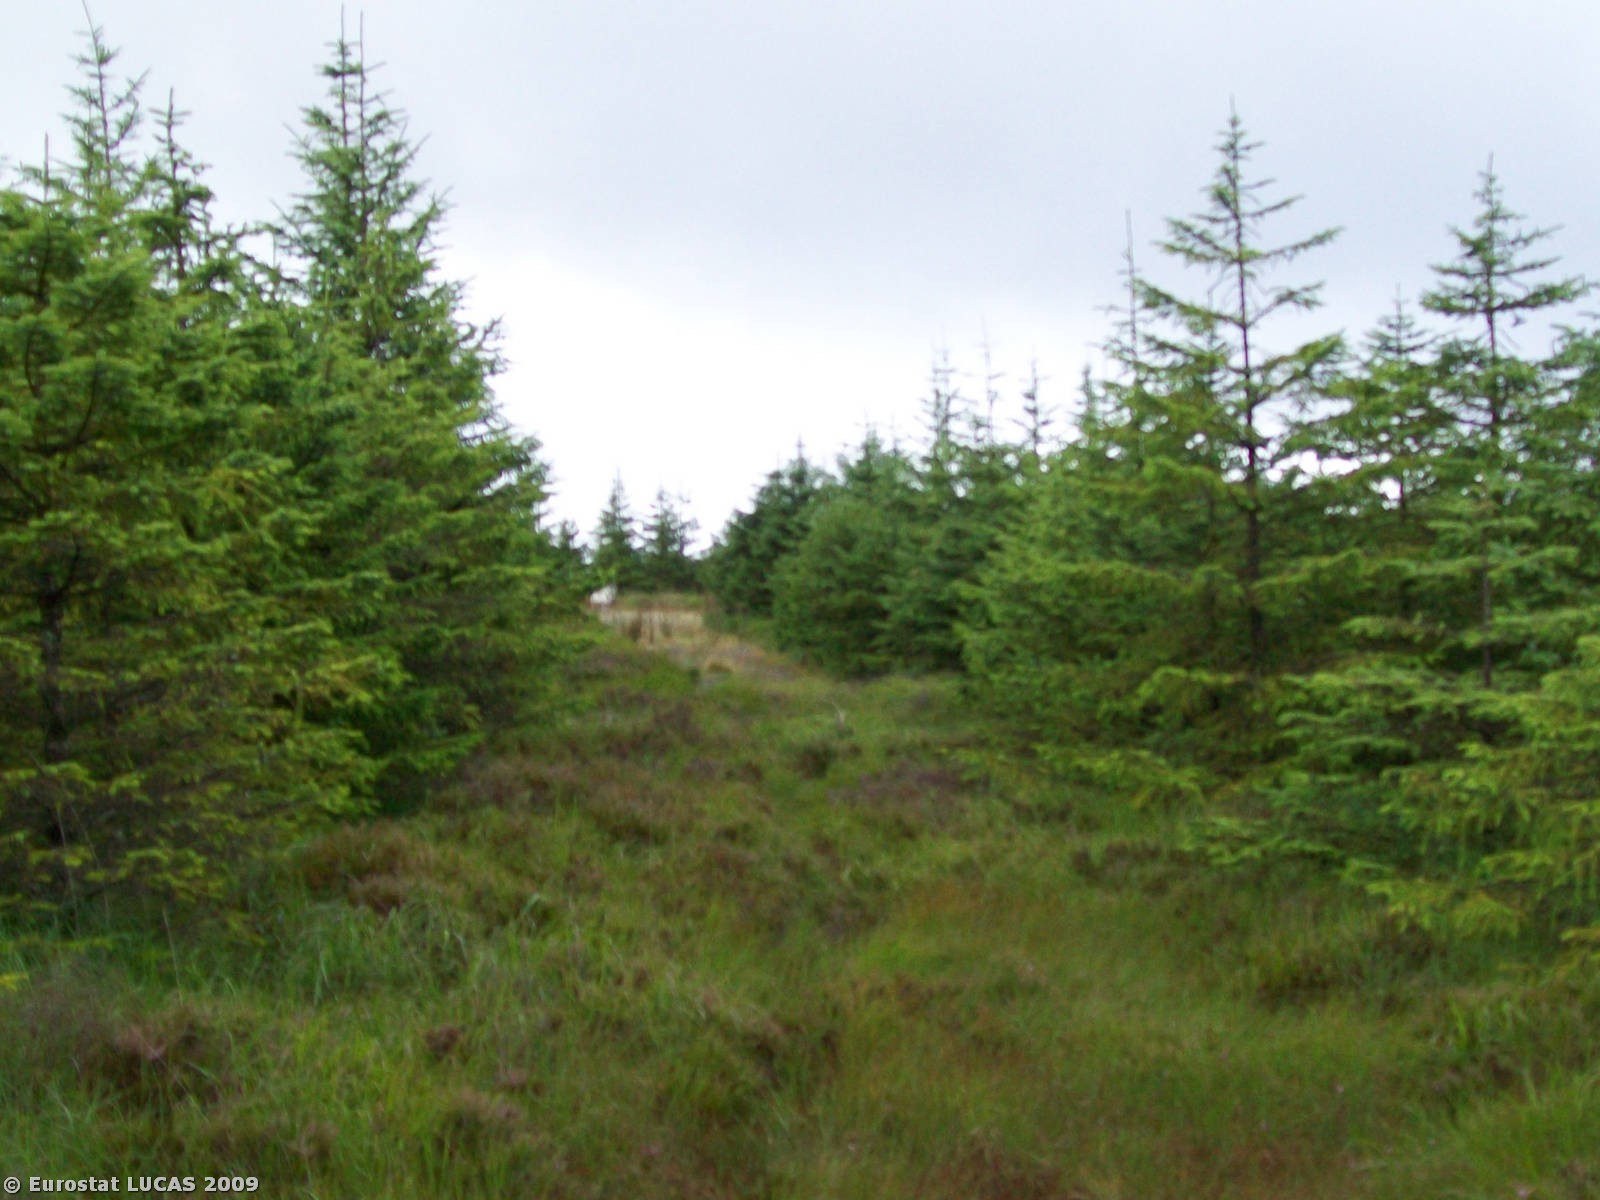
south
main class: Woodland
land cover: Coniferous woodland
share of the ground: > 75 %
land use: Forestry
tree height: < 5 m
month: August
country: IE
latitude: 53.3855
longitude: -9.3980
